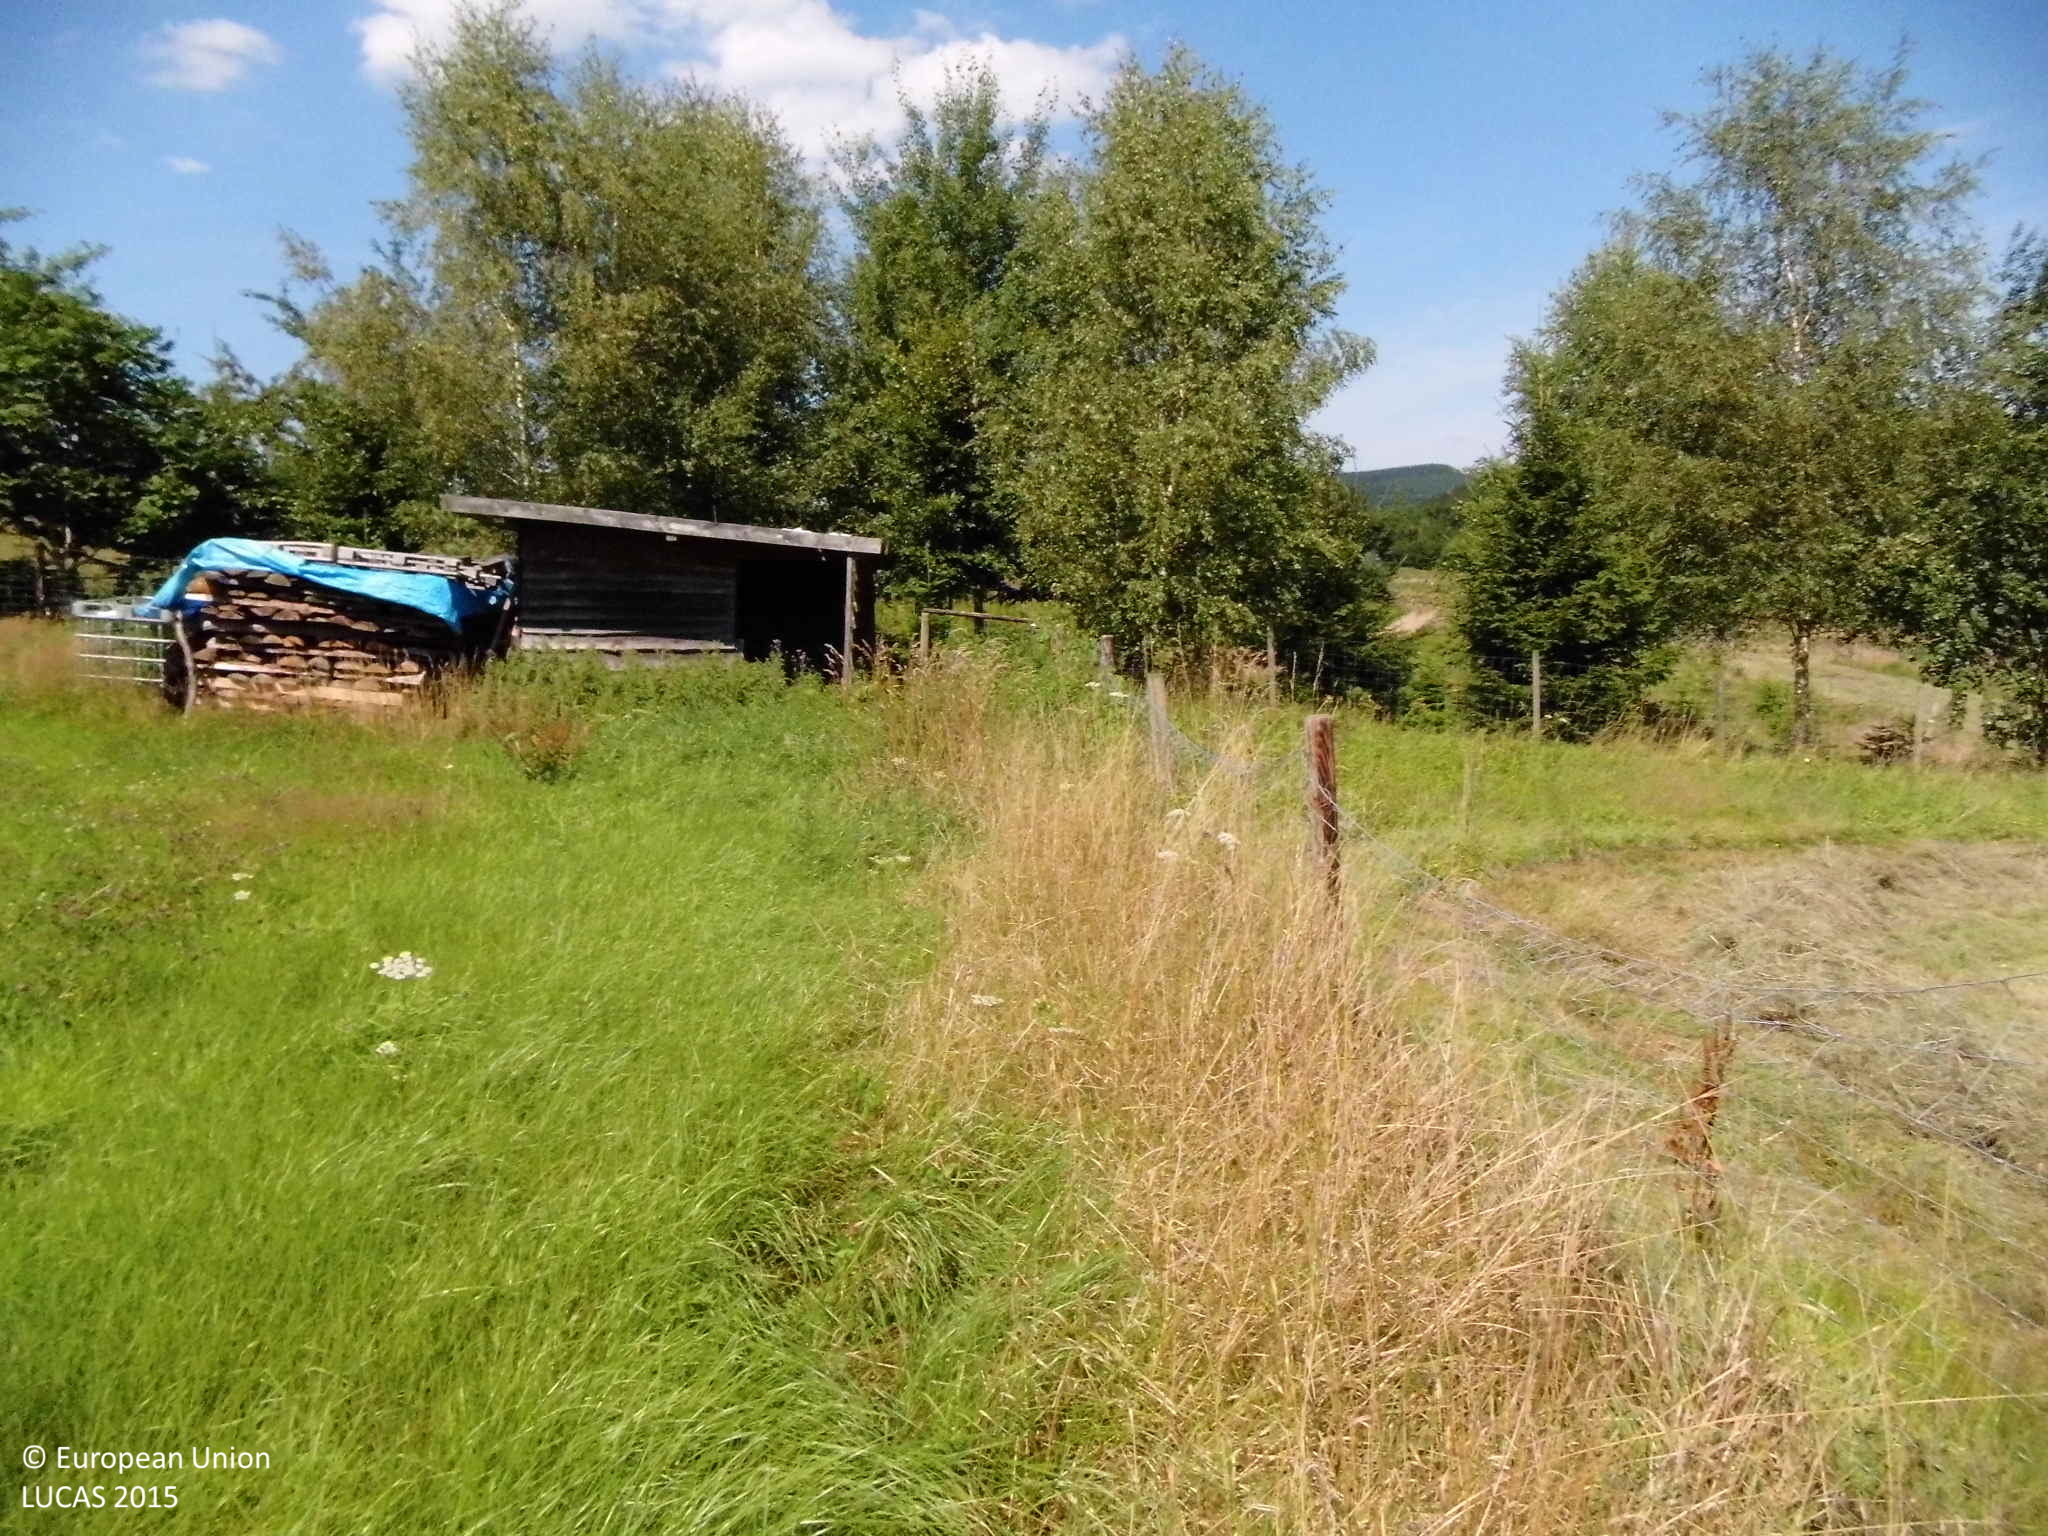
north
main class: Grassland
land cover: Grassland without tree/shrub cover
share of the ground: > 75 %
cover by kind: herbaceous plants 100 %
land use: Agriculture (excluding fallow land and kitchen gardens)
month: August
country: DE
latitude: 51.1921
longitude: 8.0114
